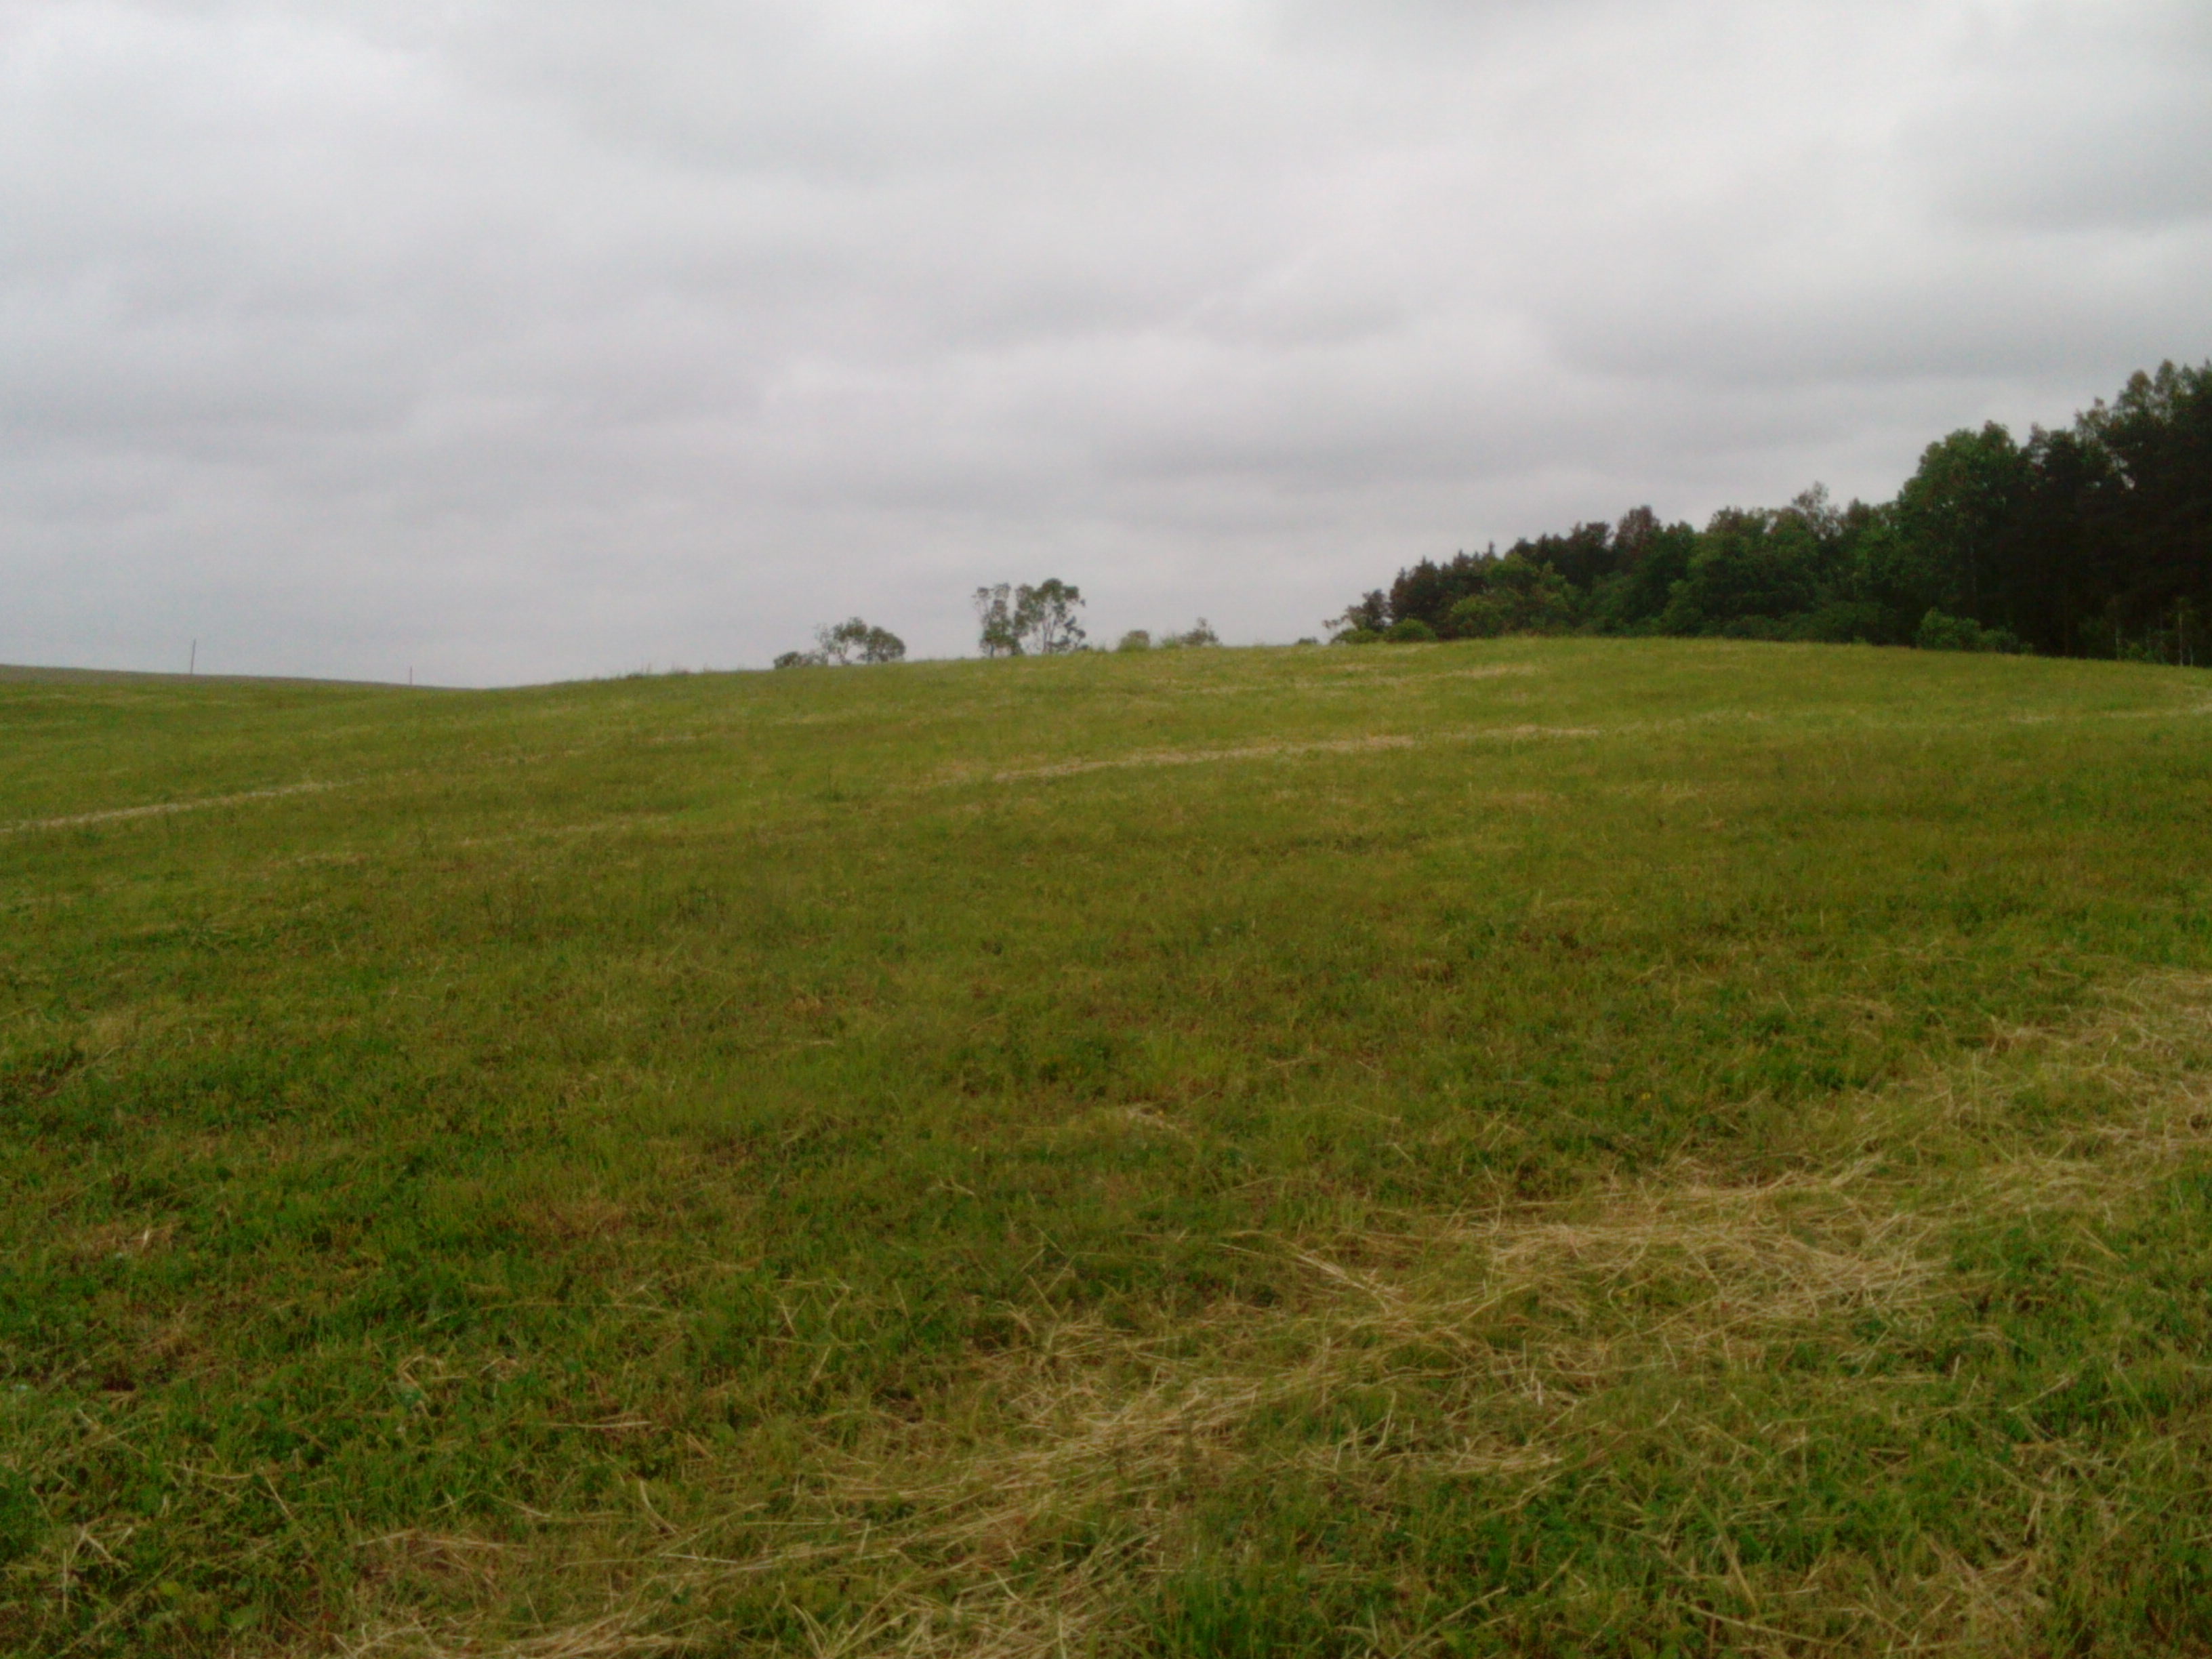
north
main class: Grassland
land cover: Grassland without tree/shrub cover
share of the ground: > 75 %
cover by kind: herbaceous plants 100 %
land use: Agriculture (excluding fallow land and kitchen gardens)
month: June
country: LV
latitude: 56.8419
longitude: 21.9986
